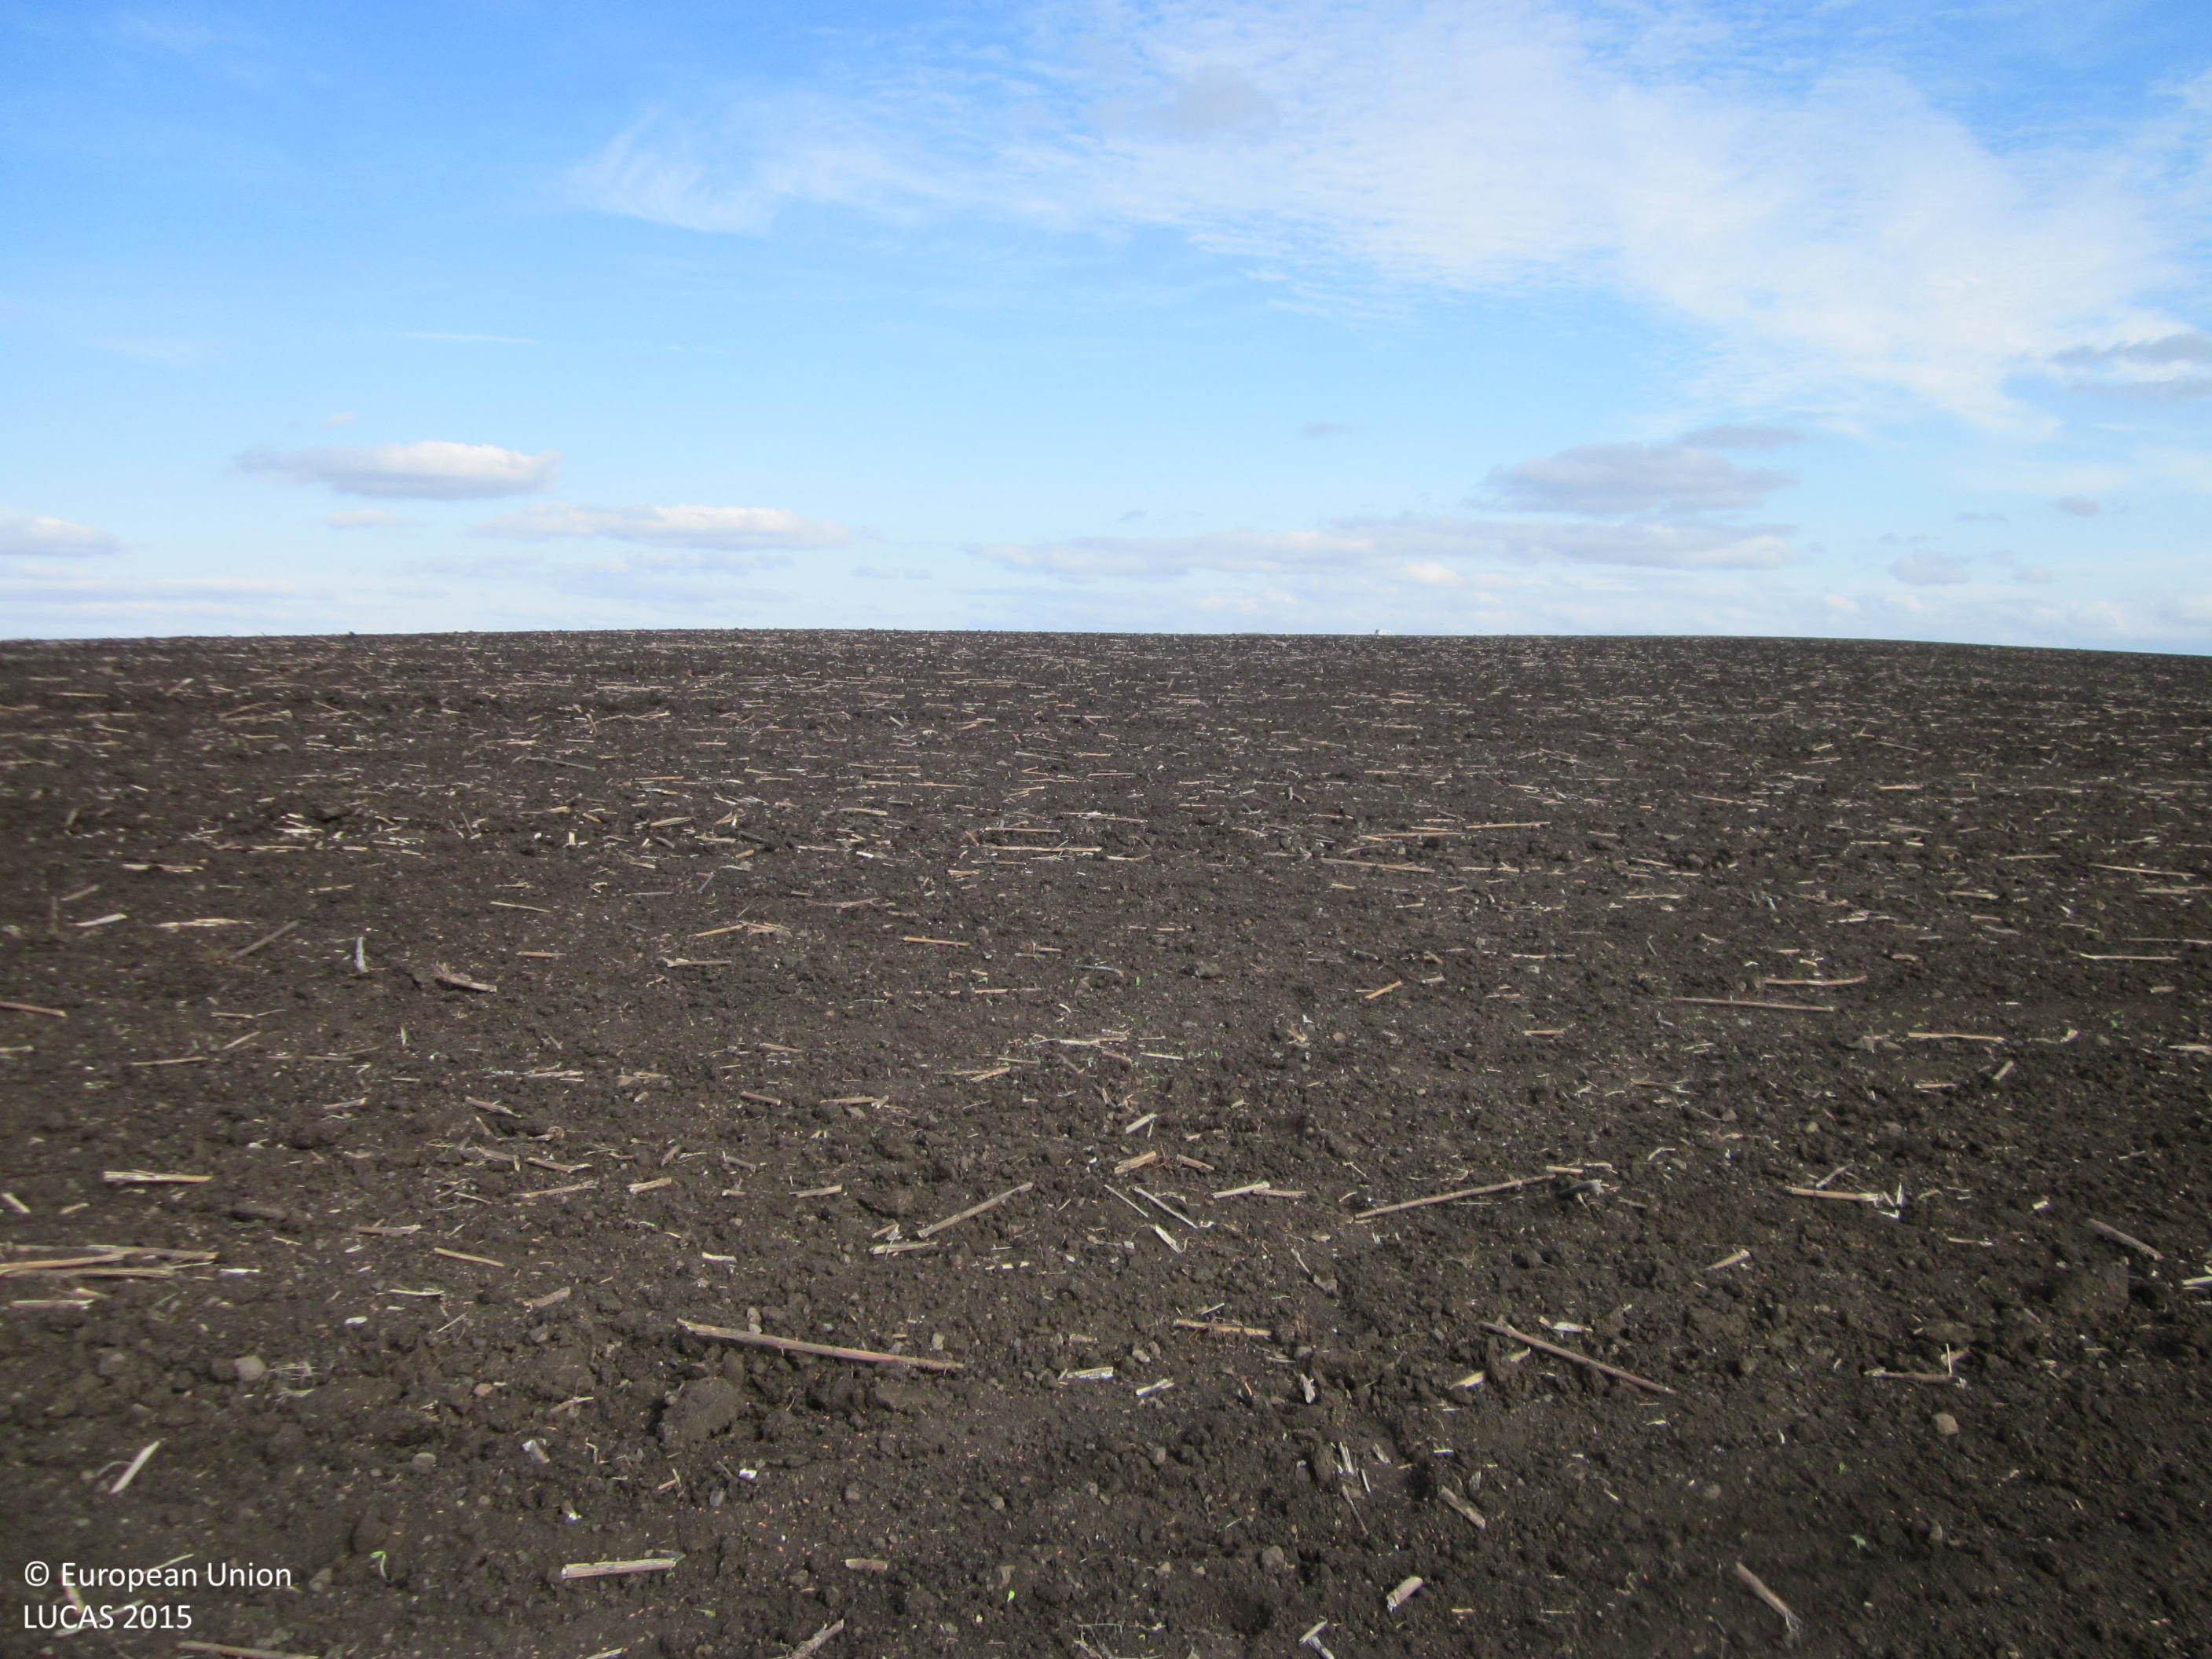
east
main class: Cropland
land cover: Sunflower
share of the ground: < 10 %
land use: Agriculture (excluding fallow land and kitchen gardens)
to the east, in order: Sunflower
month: October
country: BG
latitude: 42.4278
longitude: 27.0608
